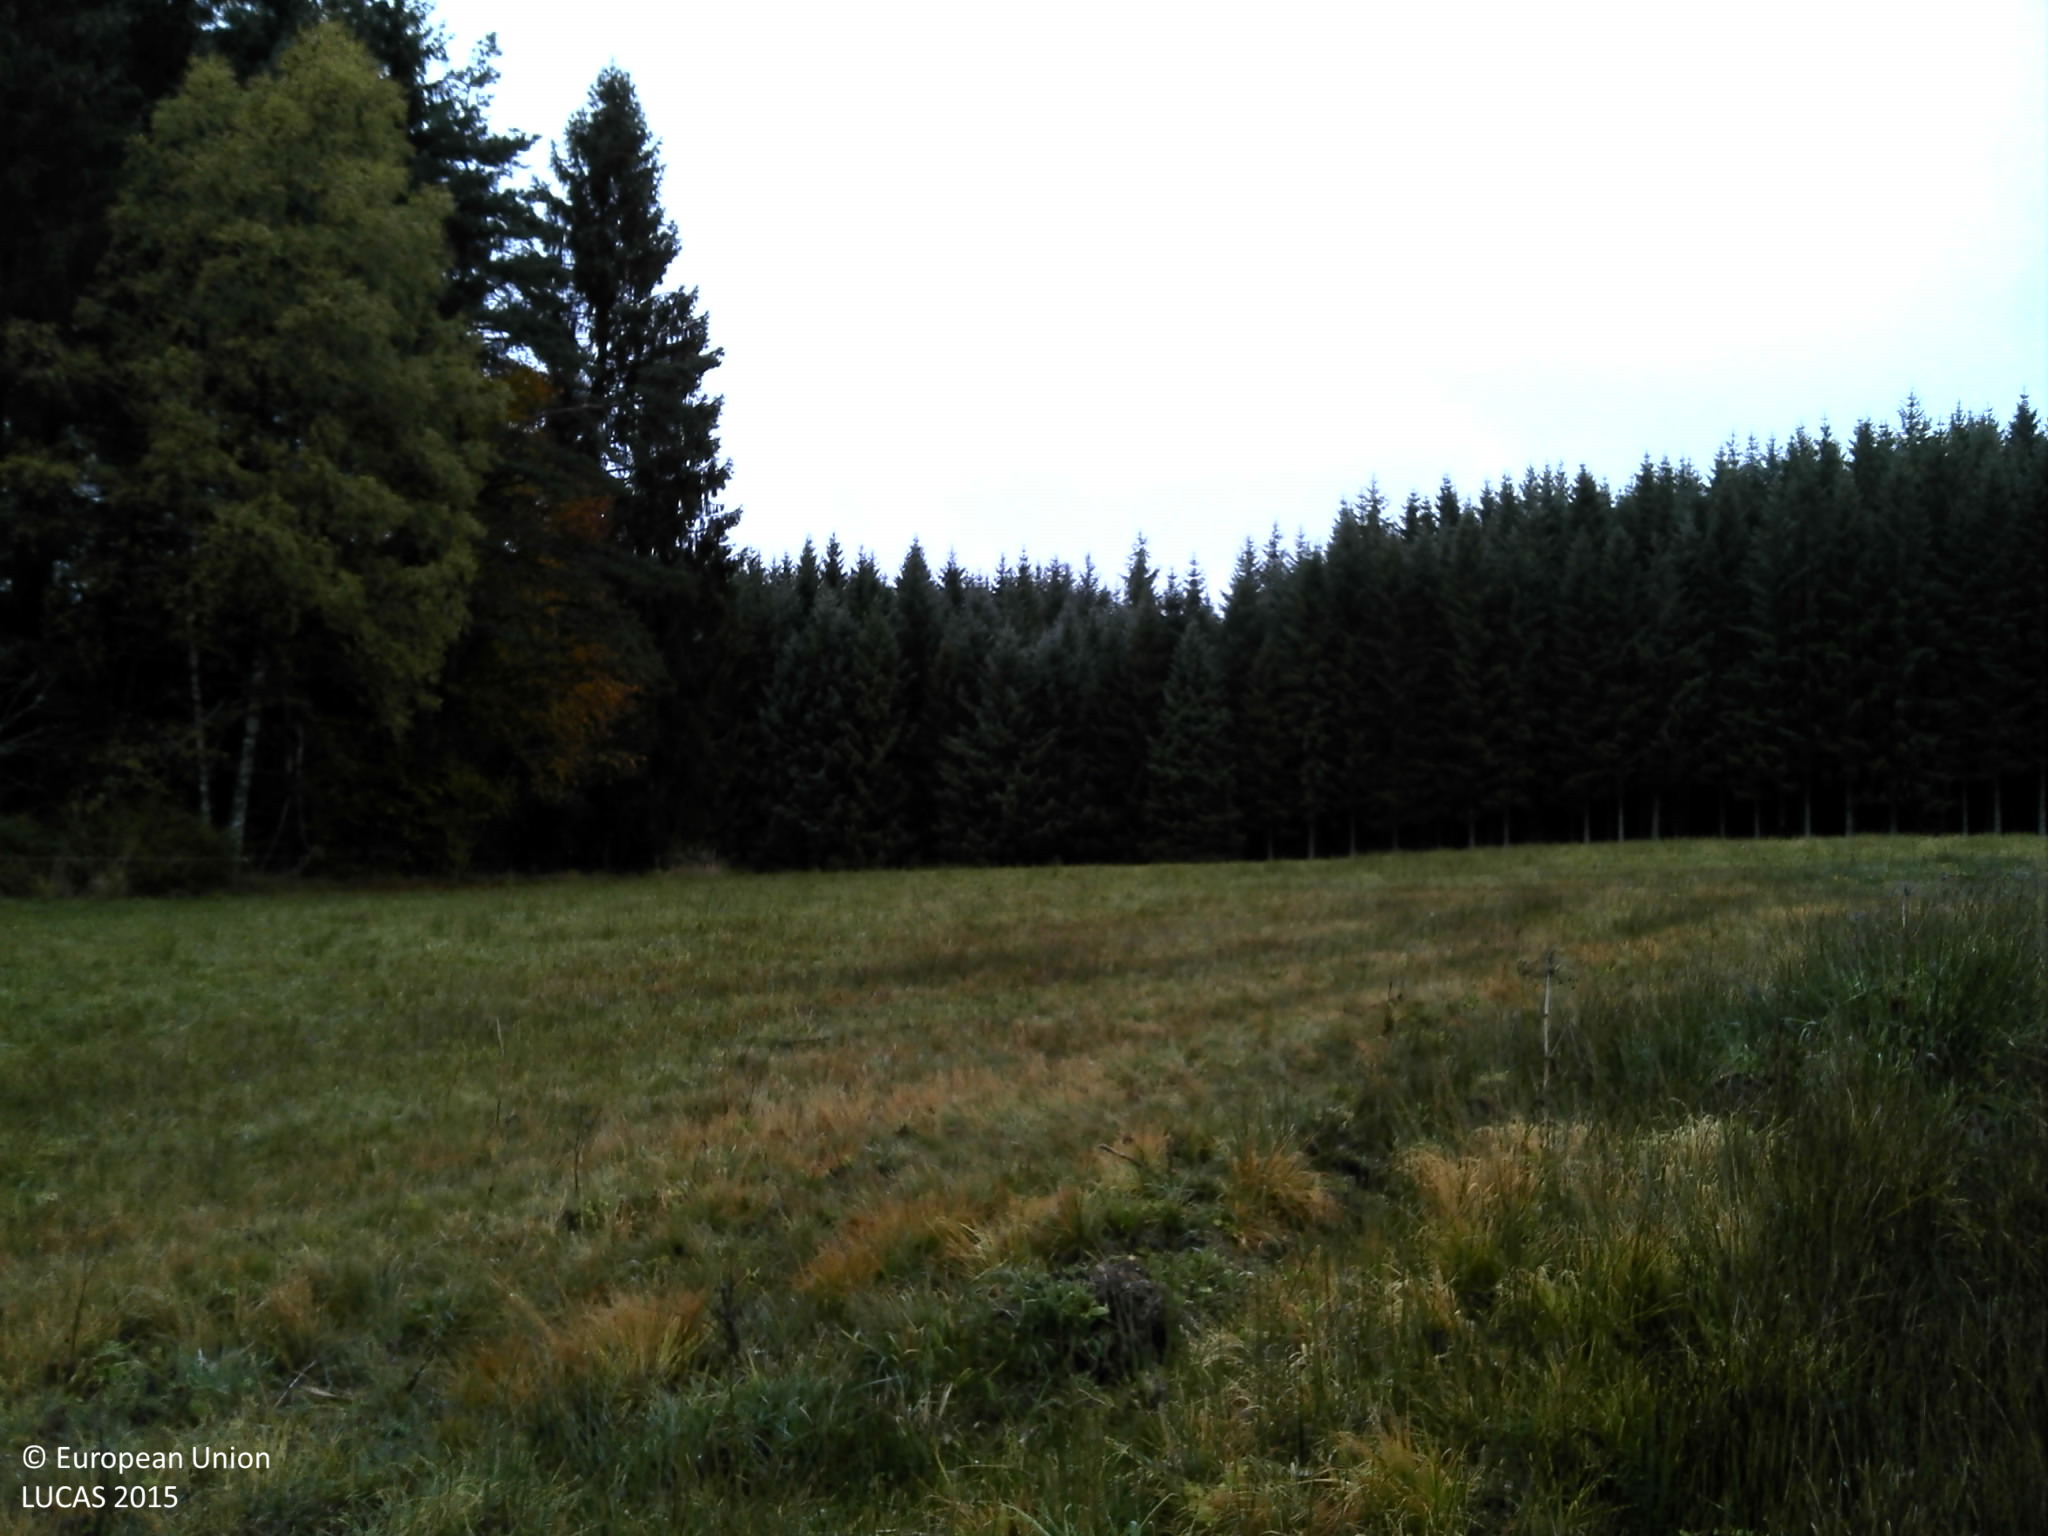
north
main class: Grassland
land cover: Grassland without tree/shrub cover
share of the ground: > 75 %
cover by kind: herbaceous plants 100 %
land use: Agriculture (excluding fallow land and kitchen gardens)
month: October
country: FR
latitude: 45.4143
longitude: 3.8310
